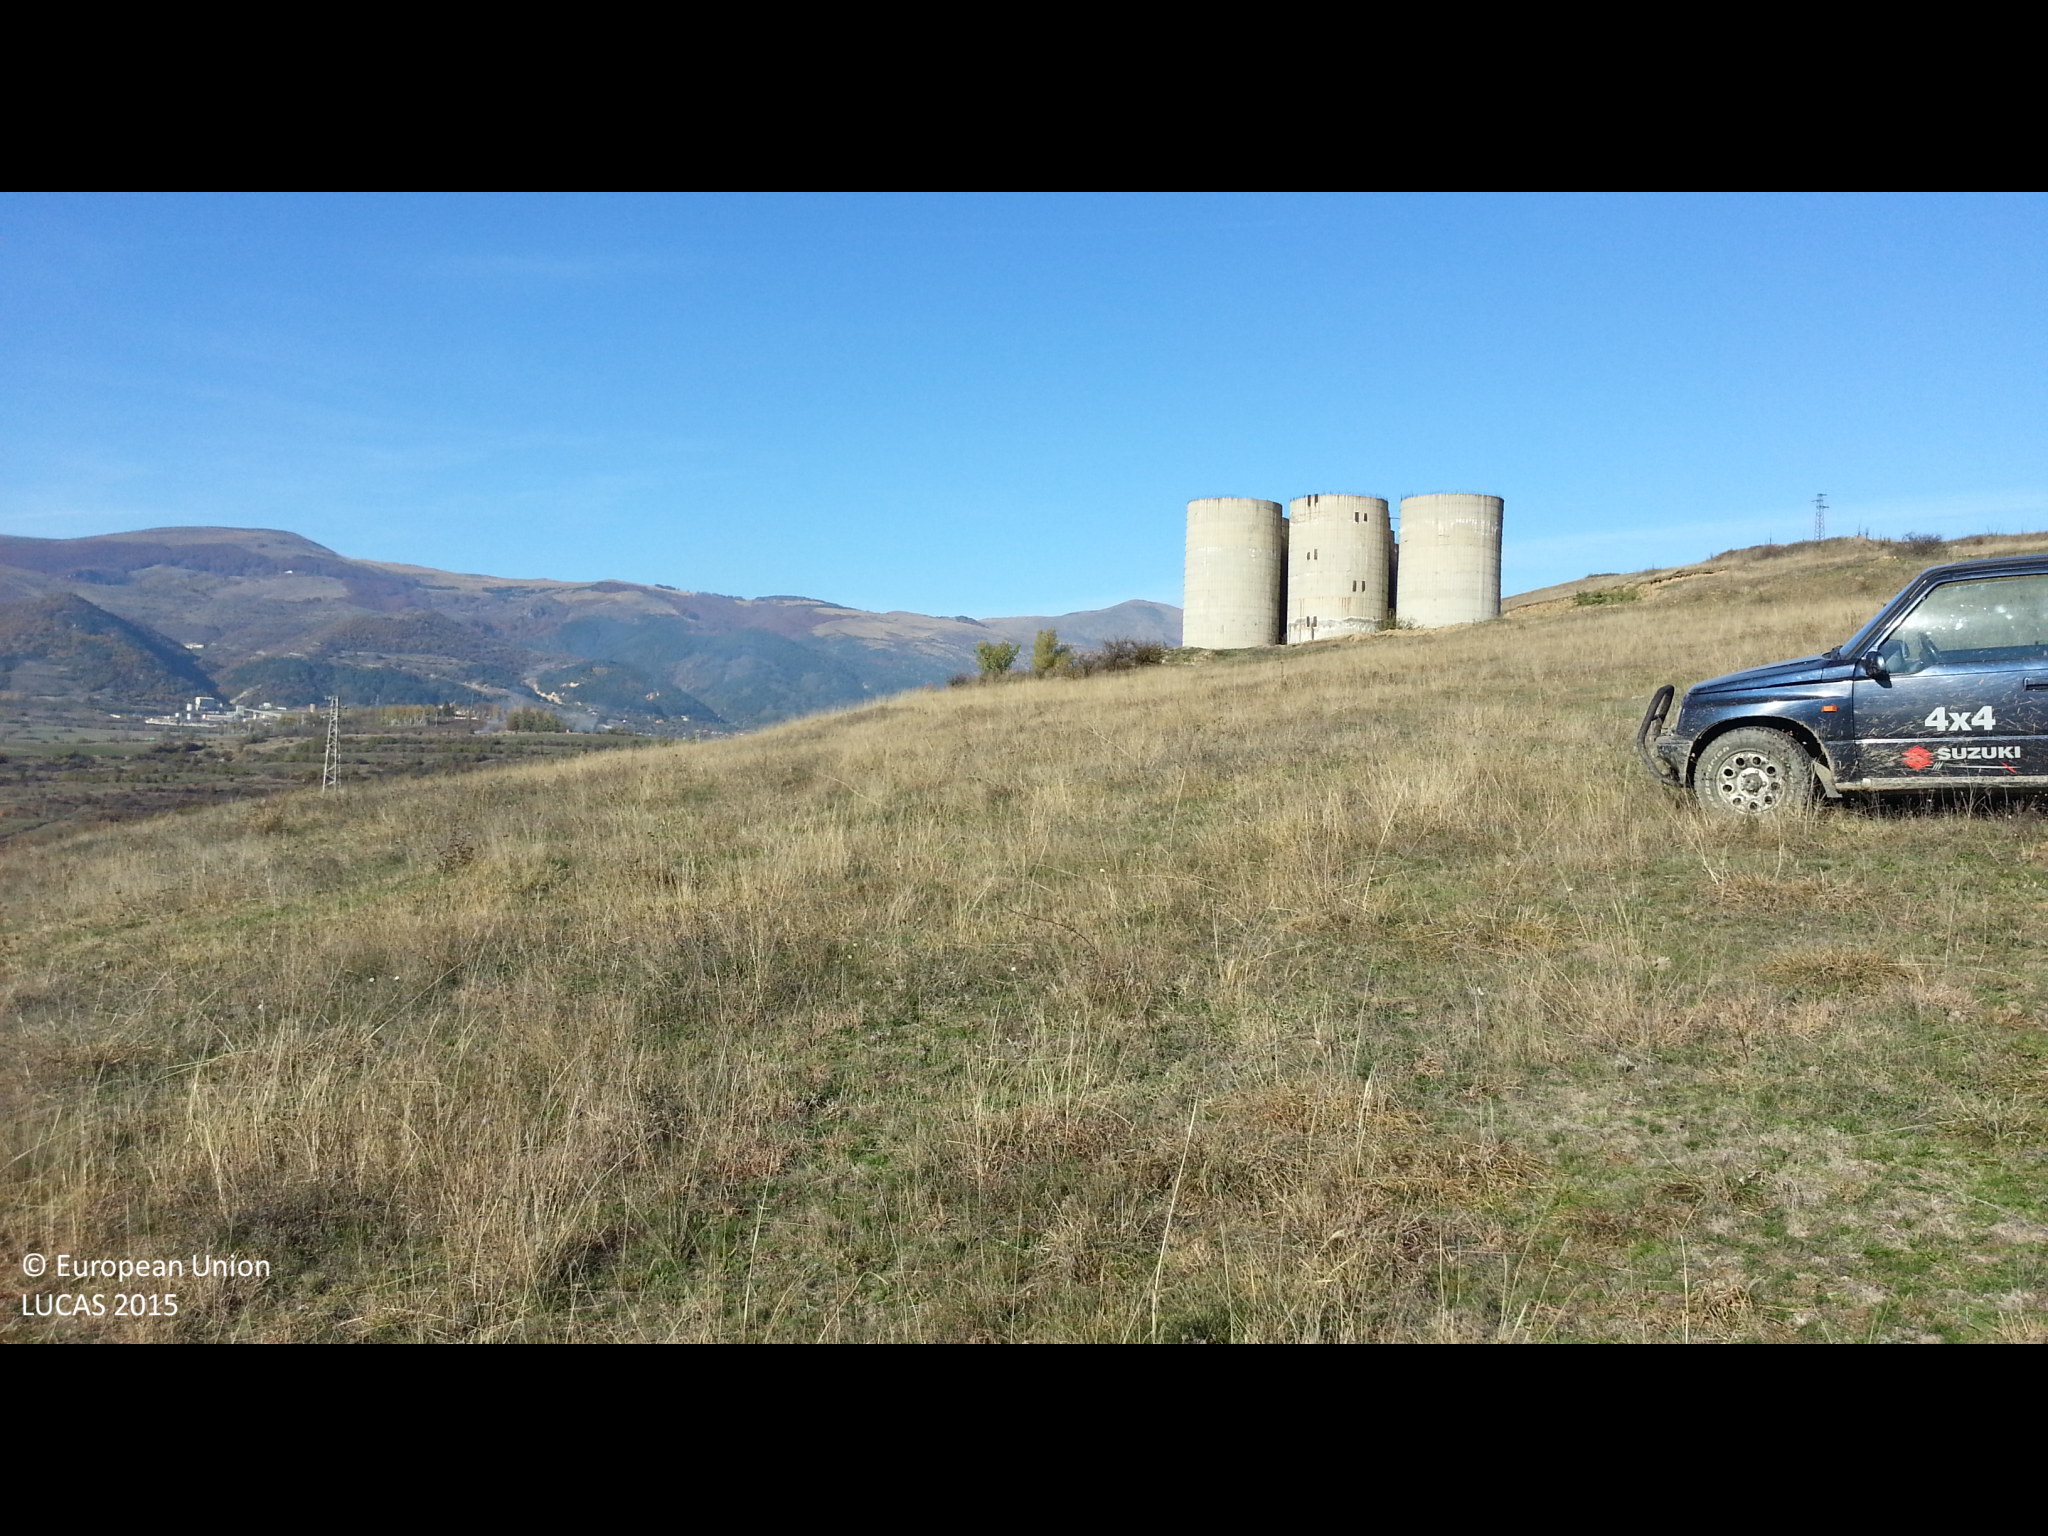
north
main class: Grassland
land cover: Grassland without tree/shrub cover
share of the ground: > 75 %
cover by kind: herbaceous plants 100 %
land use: Agriculture (excluding fallow land and kitchen gardens)
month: November
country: BG
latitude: 42.6701
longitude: 24.0900
